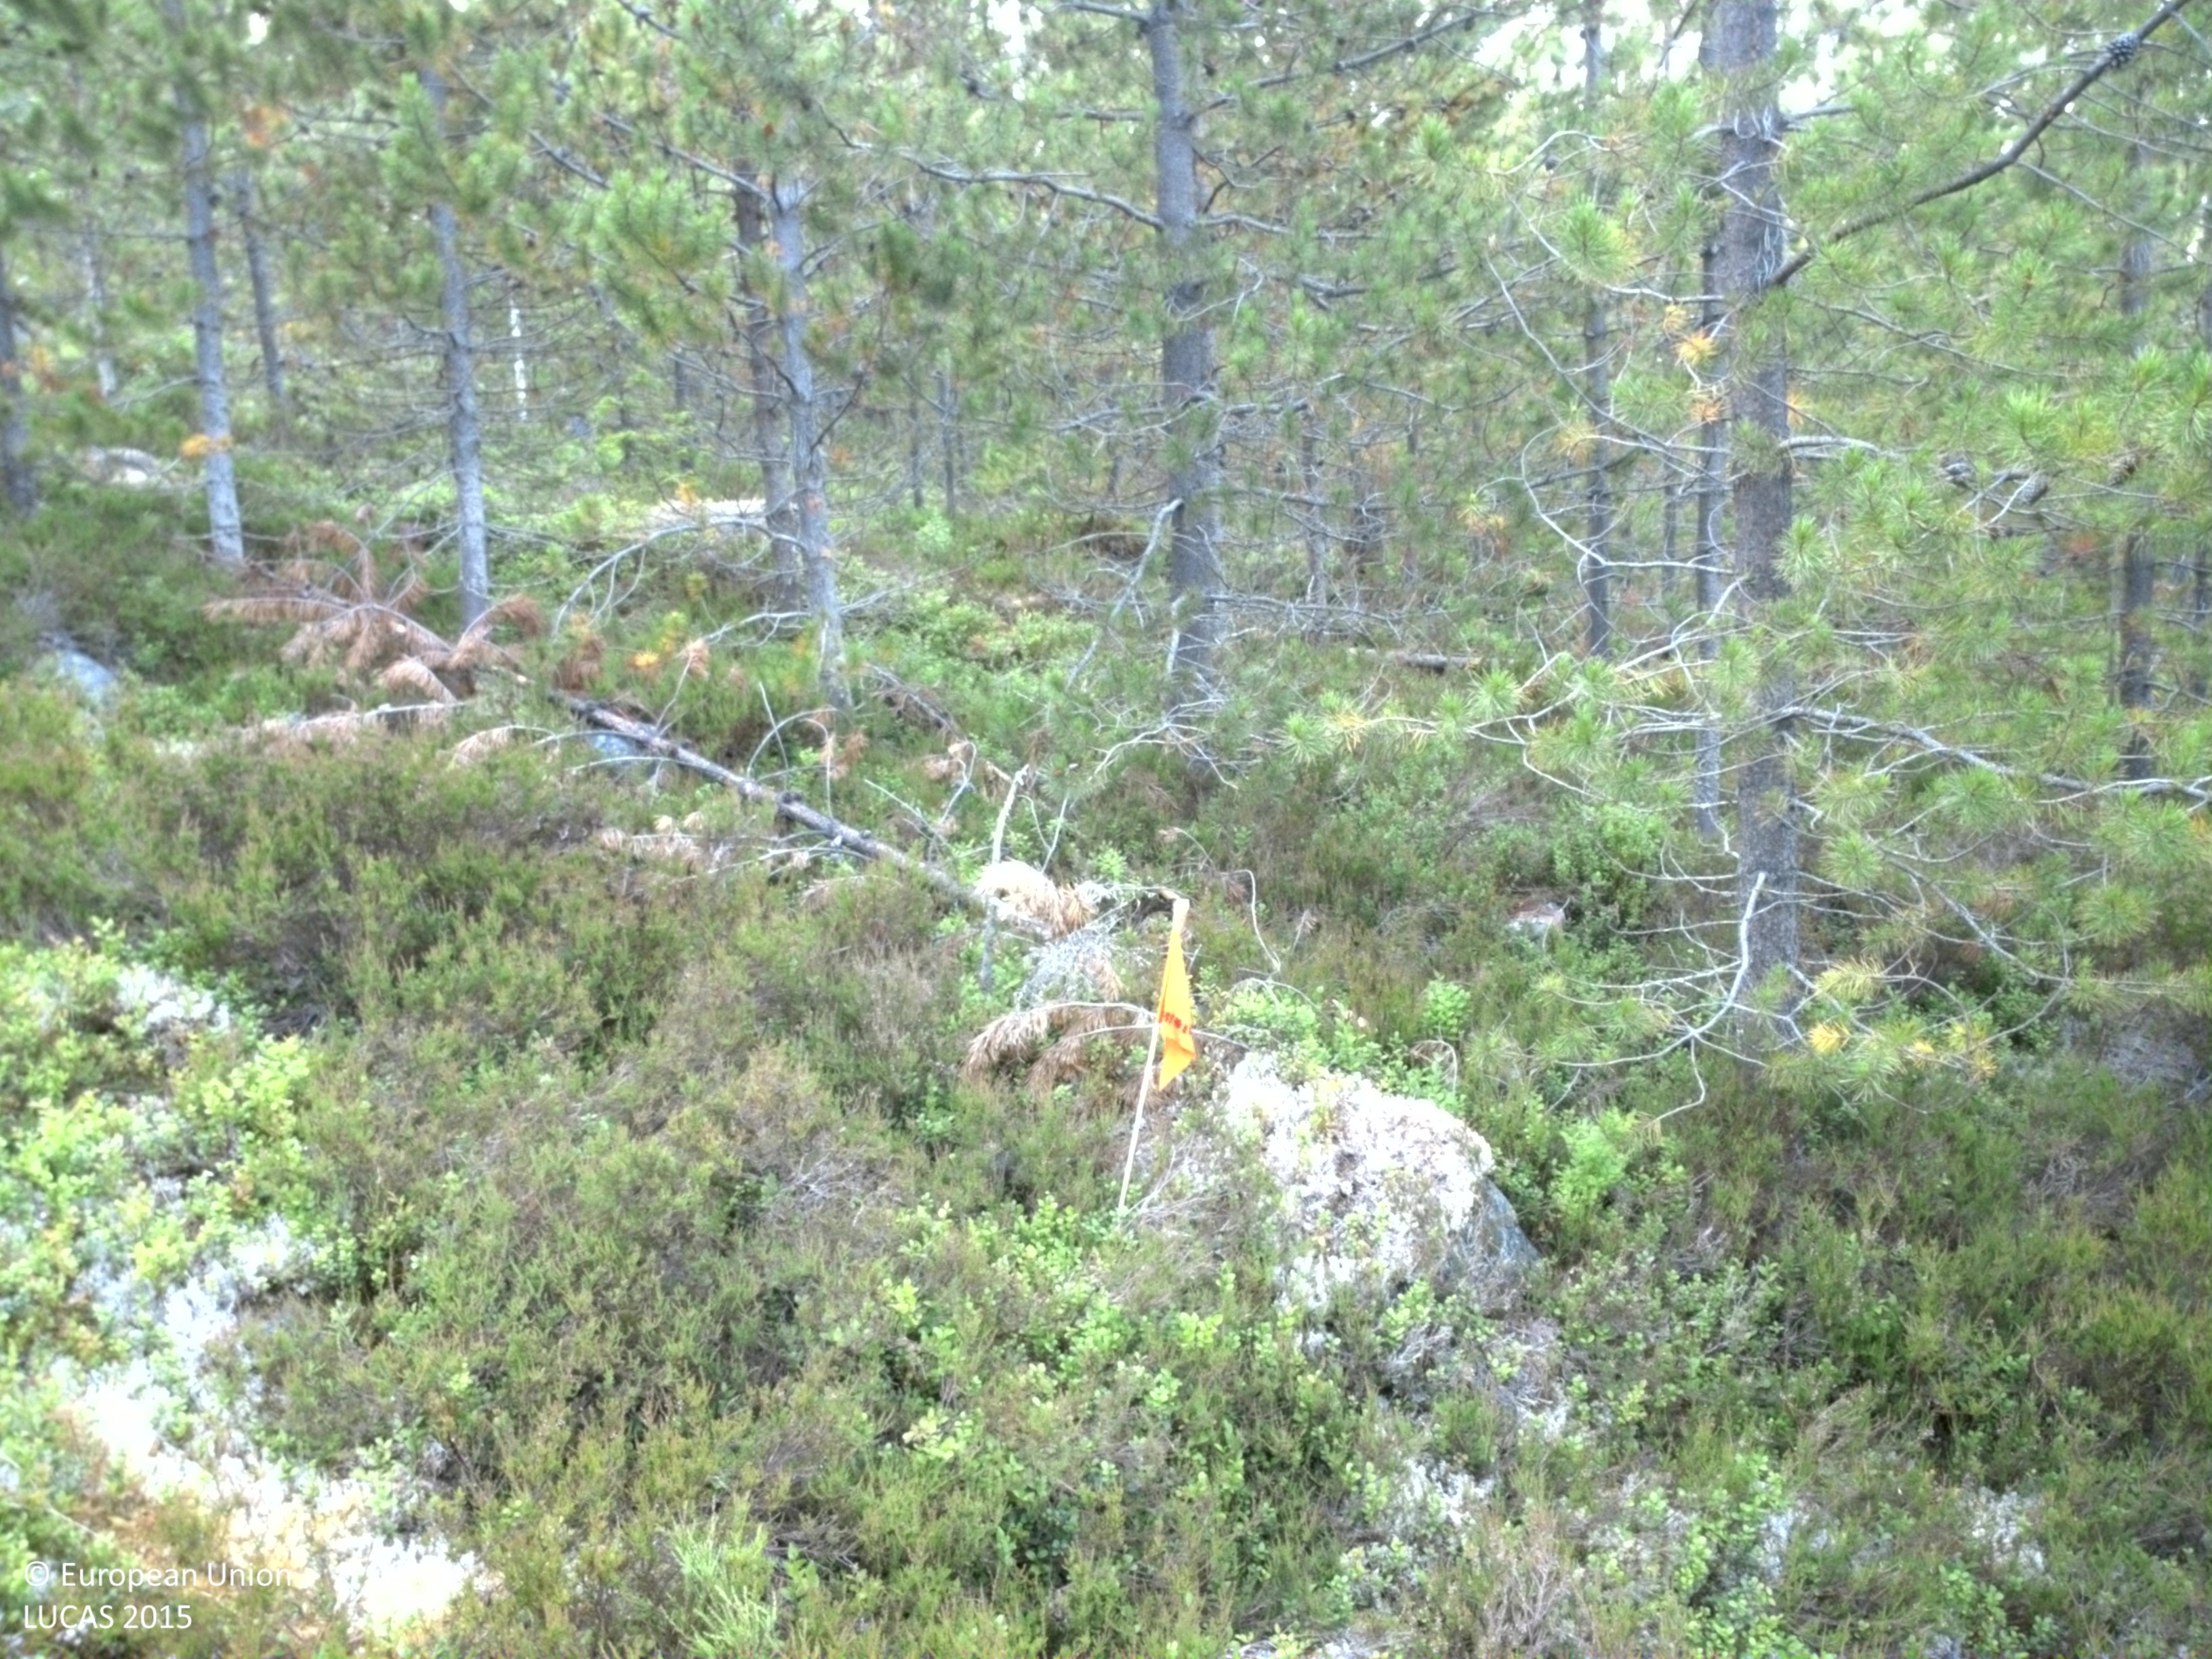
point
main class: Woodland
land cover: Pine dominated coniferous woodland
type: exotic forest
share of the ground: 50 - 75 %
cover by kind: coniferous forest trees 65 %, shrubs 35 %
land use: Forestry
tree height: < 5 m
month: August
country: SE
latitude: 61.9357
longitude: 14.3472
